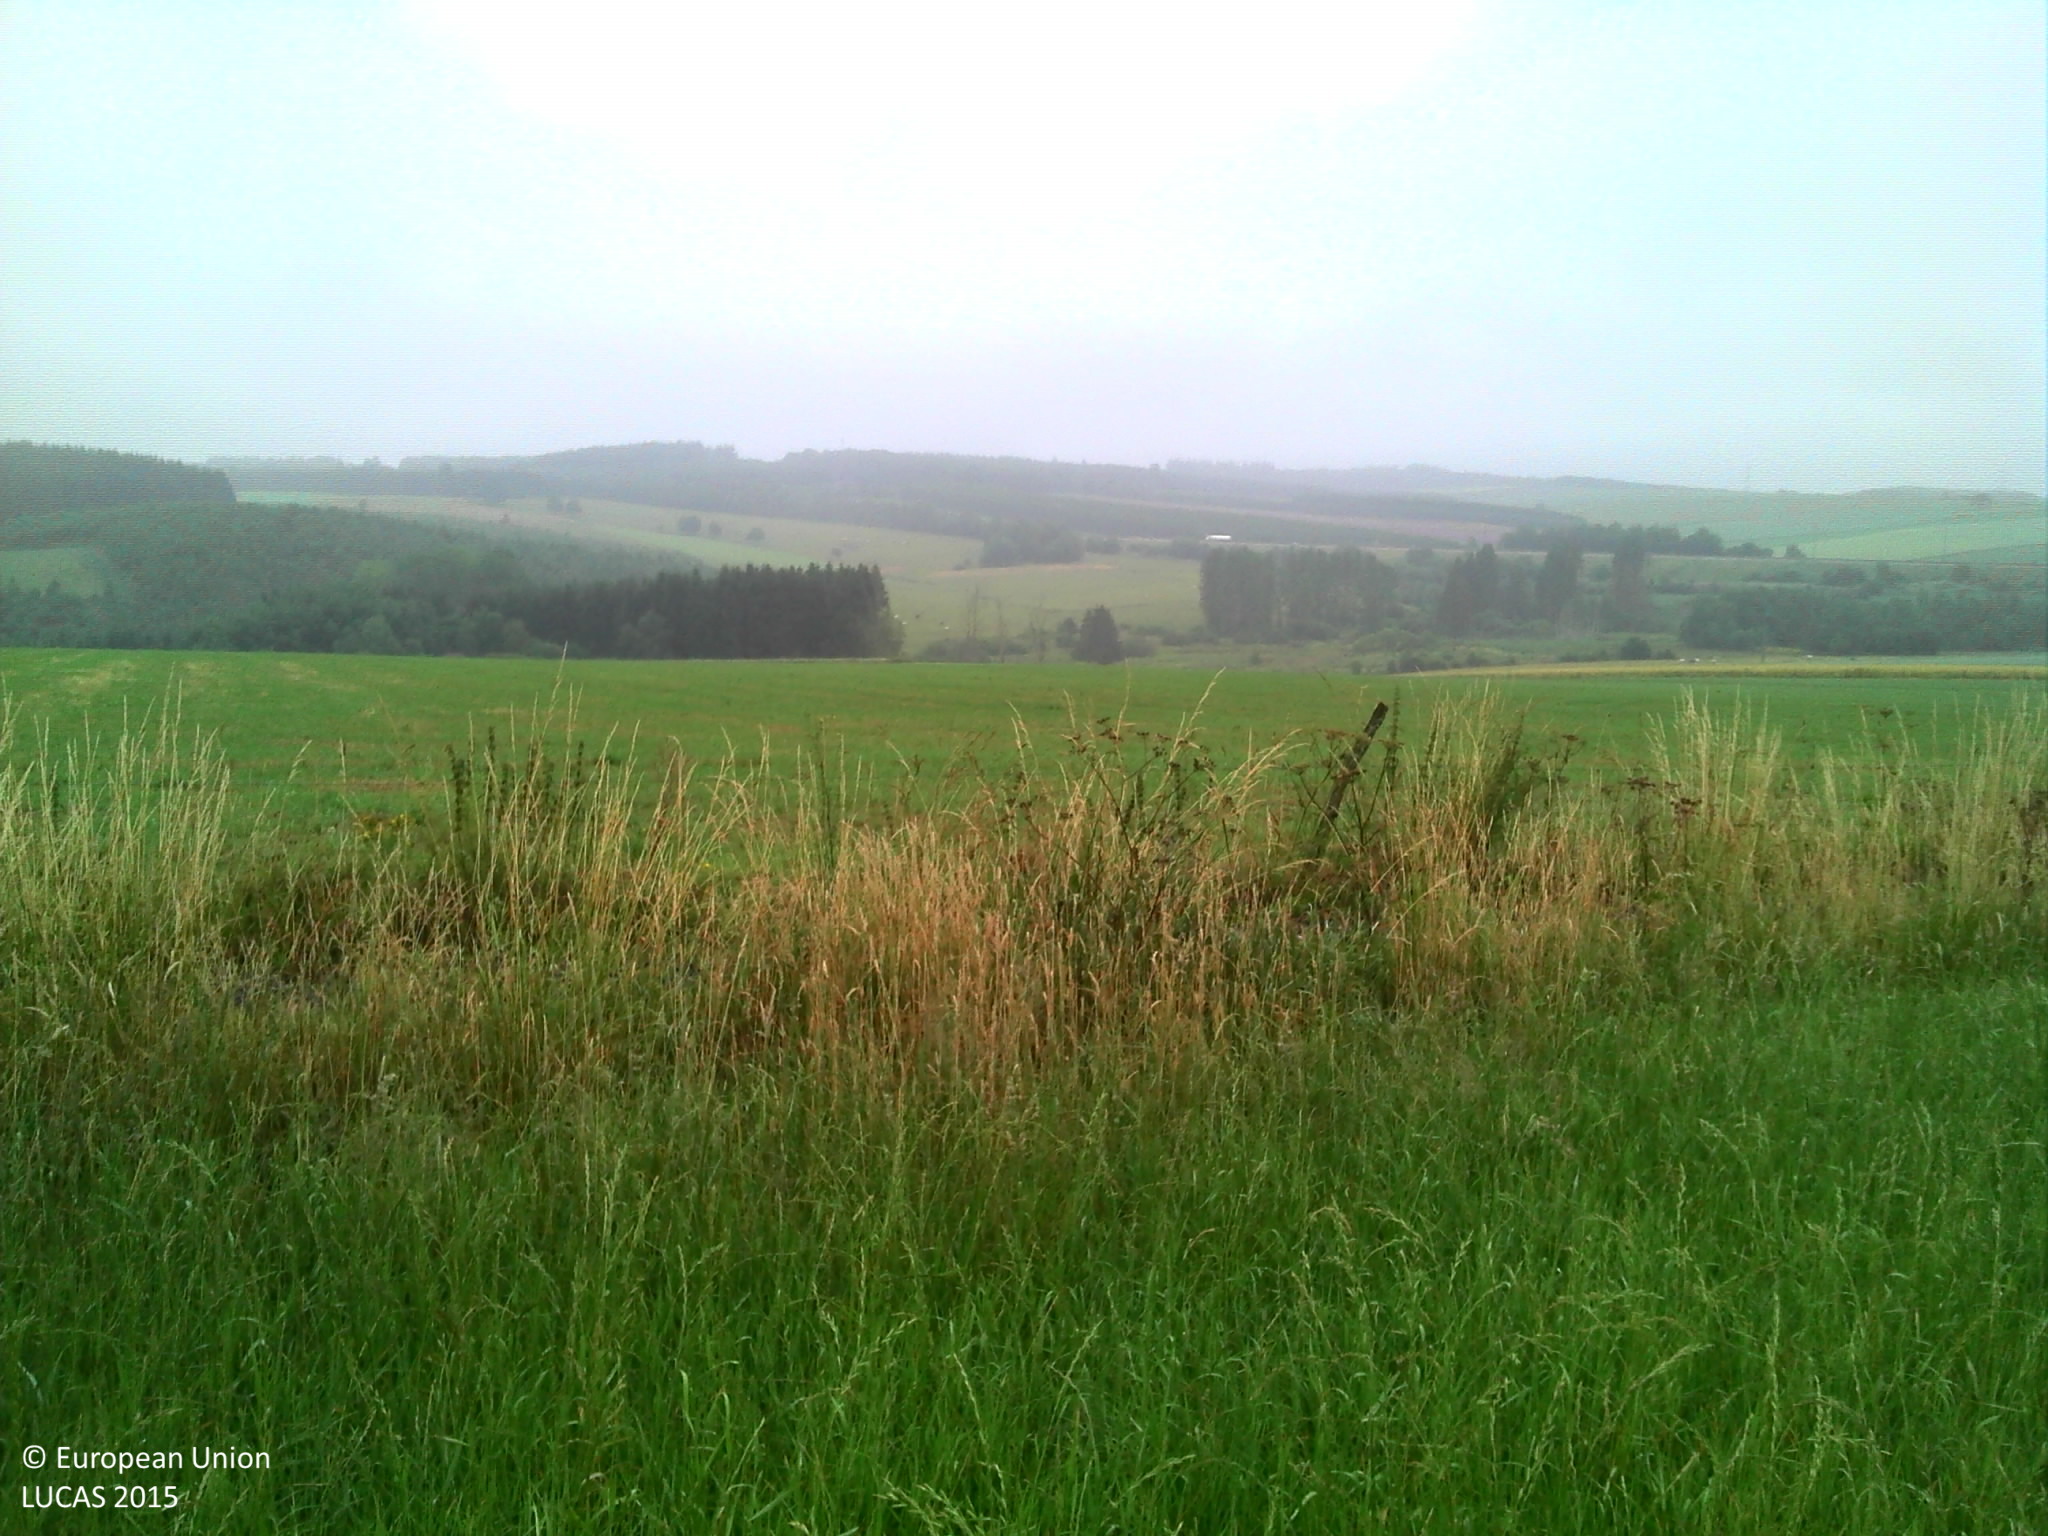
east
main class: Grassland
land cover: Grassland without tree/shrub cover
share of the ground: > 75 %
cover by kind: herbaceous plants 100 %
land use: Agriculture (excluding fallow land and kitchen gardens)
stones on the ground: < 10 %
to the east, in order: Grassland without tree/shrub cover; Grass margins; Tracks; Grass margins; Fences; Grassland without tree/shrub cover
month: July
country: BE
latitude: 50.0865
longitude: 5.7359
